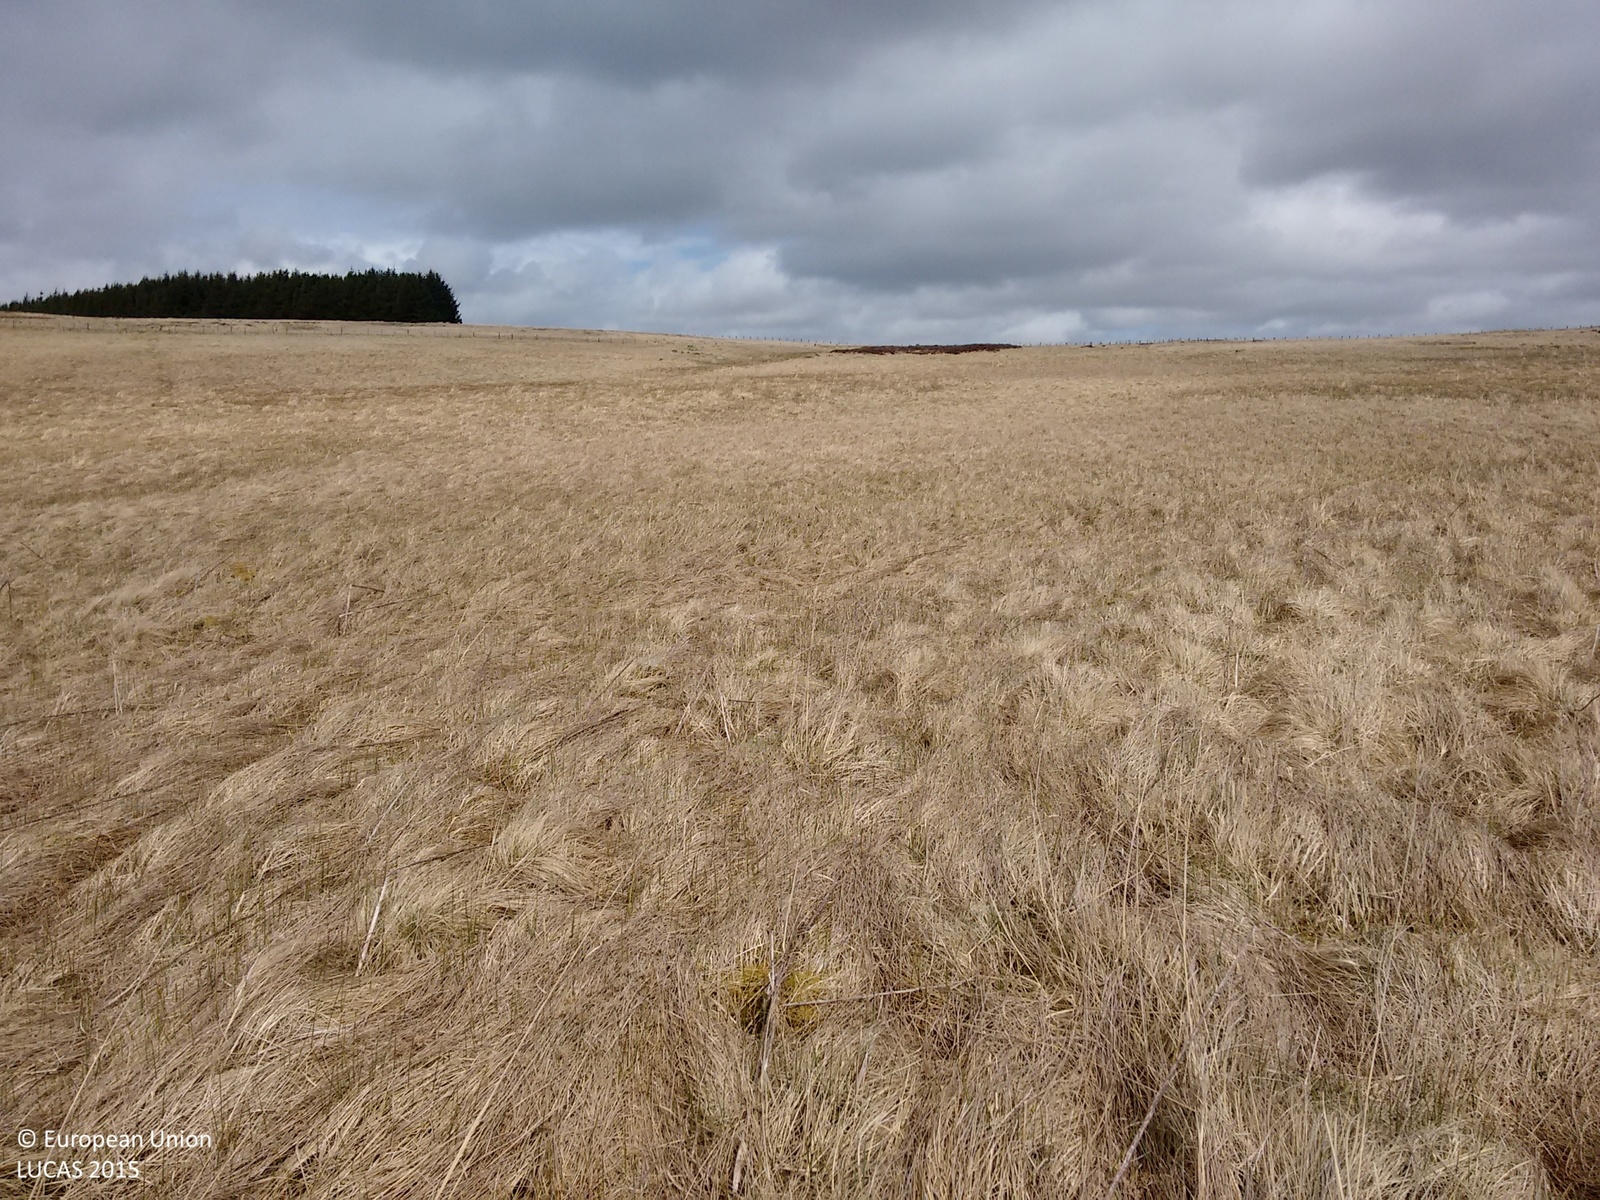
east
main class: Grassland
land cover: Grassland without tree/shrub cover
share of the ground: > 75 %
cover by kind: herbaceous plants 100 %
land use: Agriculture (excluding fallow land and kitchen gardens)
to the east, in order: Grassland without tree/shrub cover; Shrubland without tree cover
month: May
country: GB
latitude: 55.2143
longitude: -2.0786
